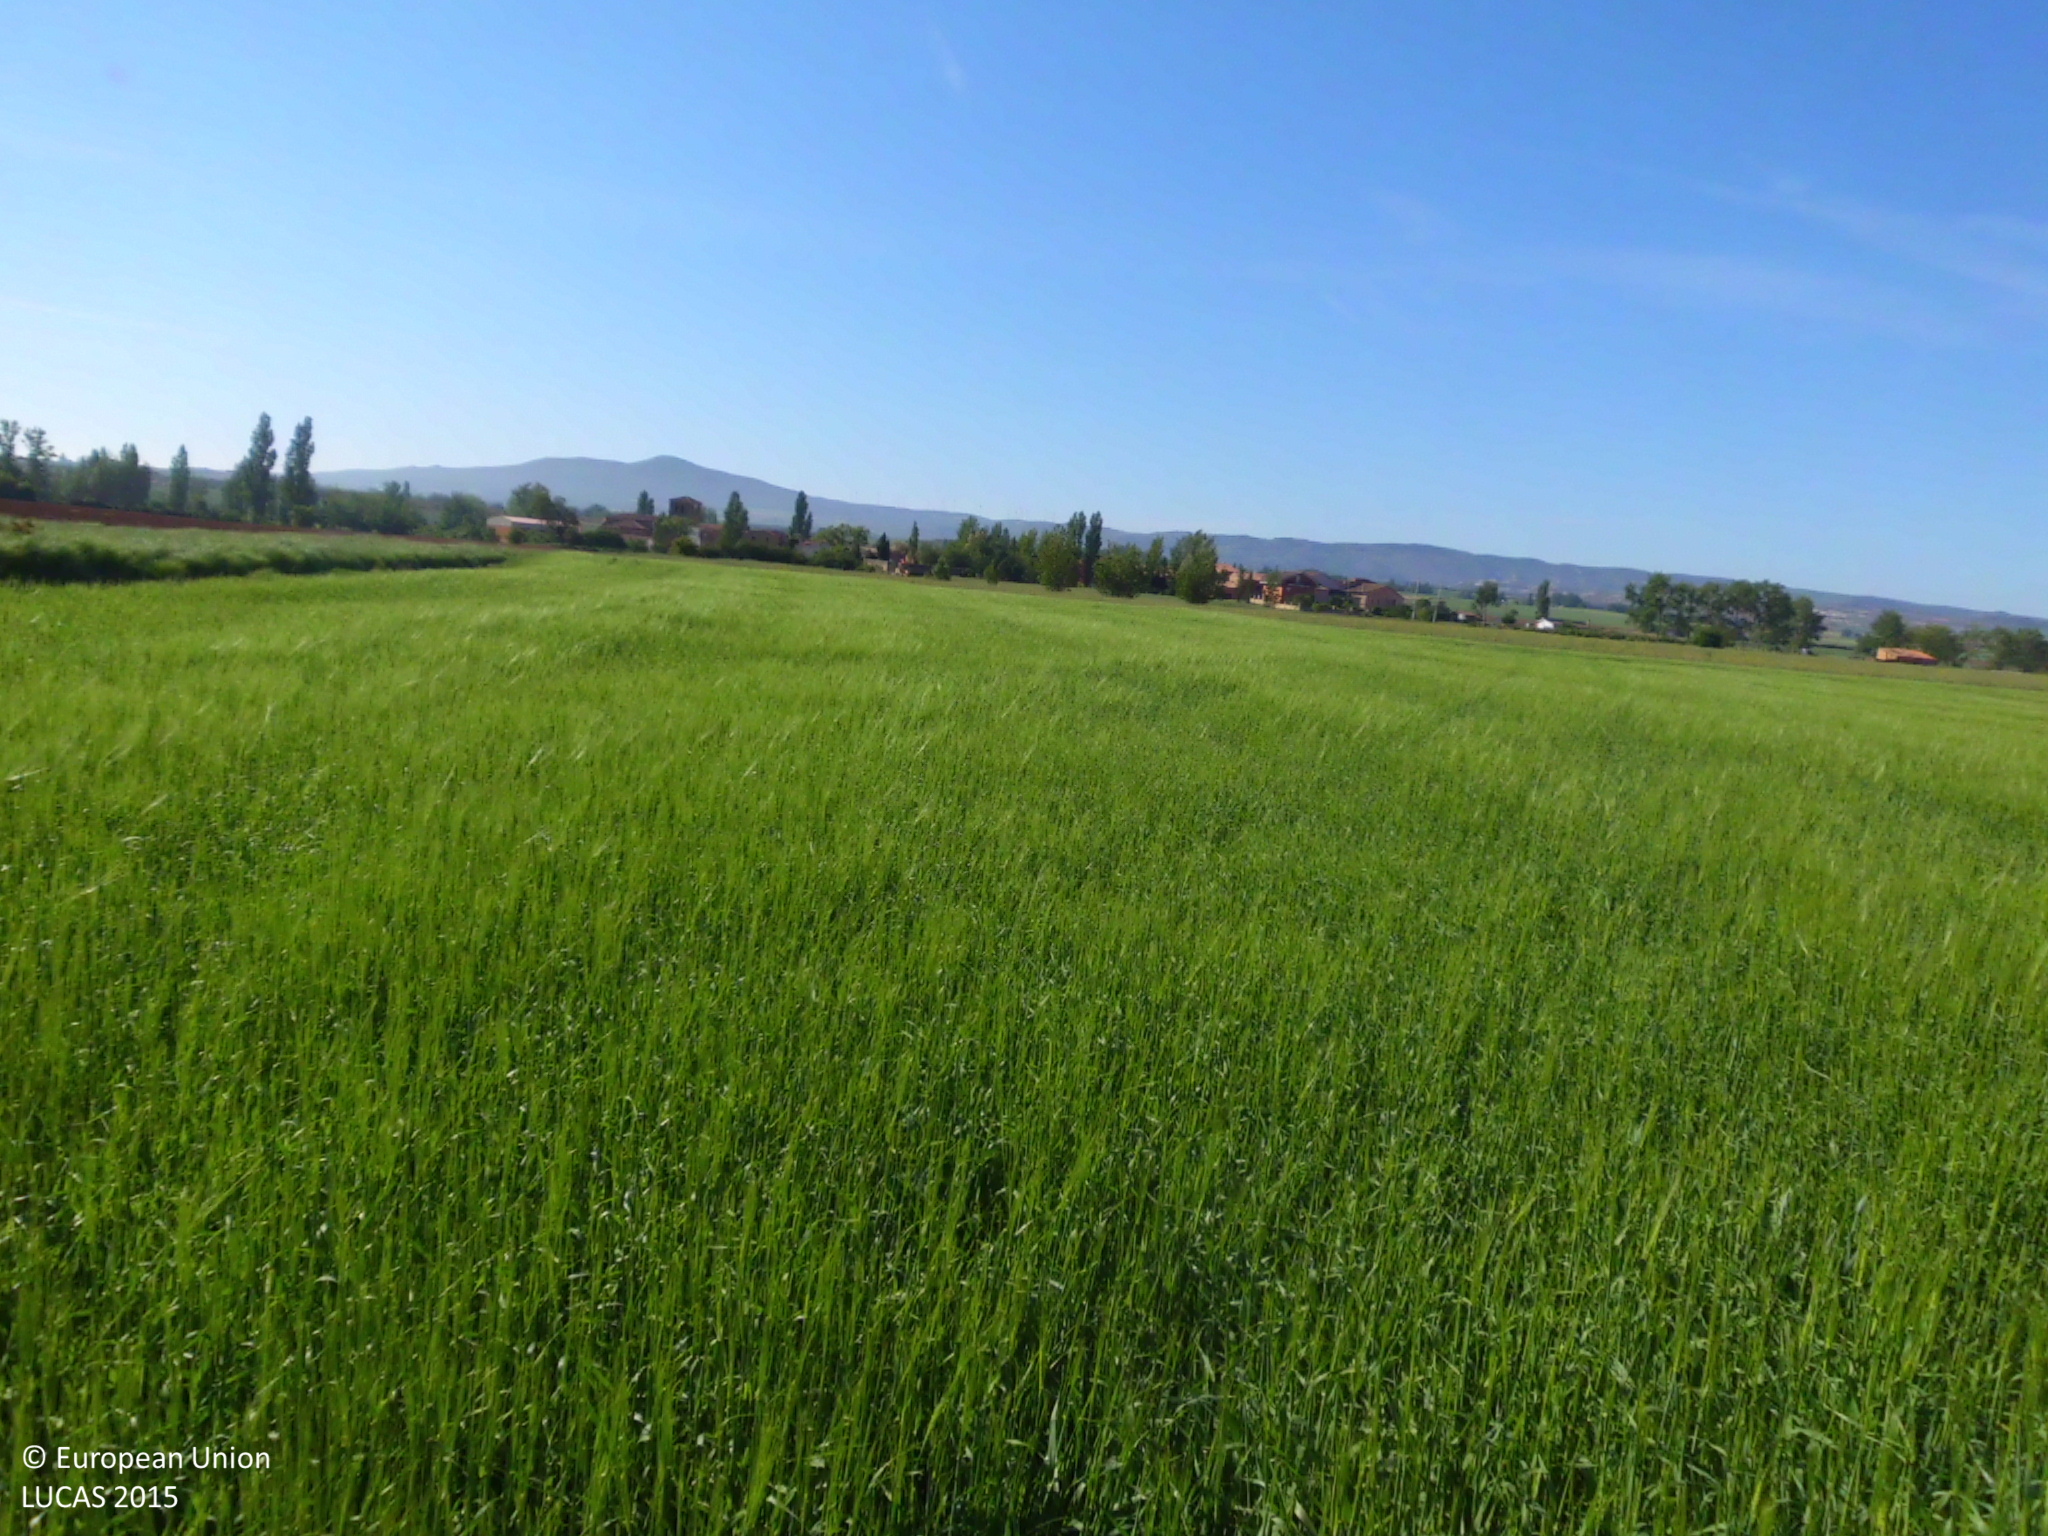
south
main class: Cropland
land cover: Barley
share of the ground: > 75 %
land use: Agriculture (excluding fallow land and kitchen gardens)
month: May
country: ES
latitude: 42.6284
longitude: -3.4607
